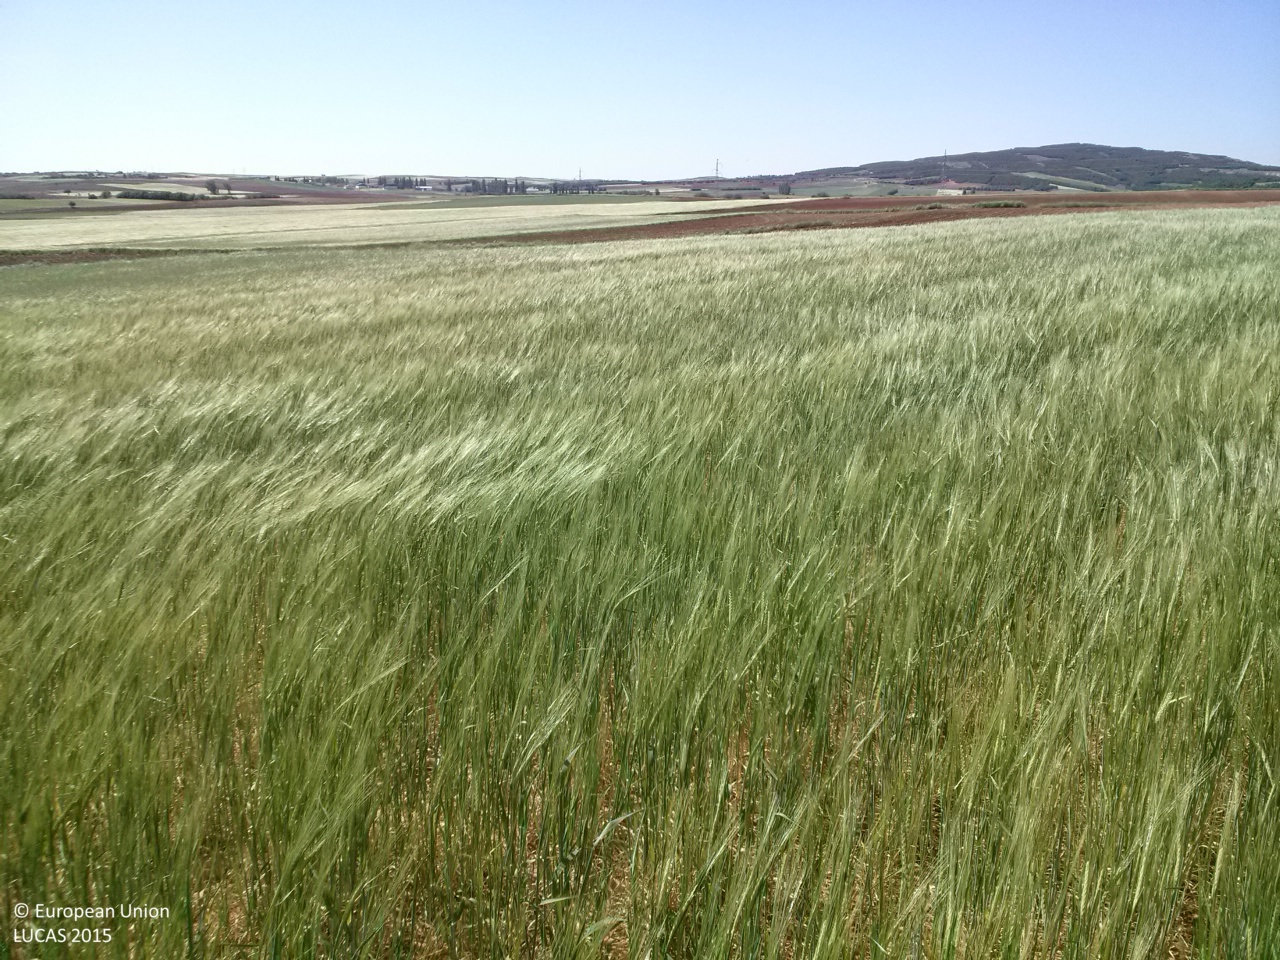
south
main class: Cropland
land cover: Barley
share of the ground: > 75 %
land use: Agriculture (excluding fallow land and kitchen gardens)
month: May
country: ES
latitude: 40.0072
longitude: -2.8257
